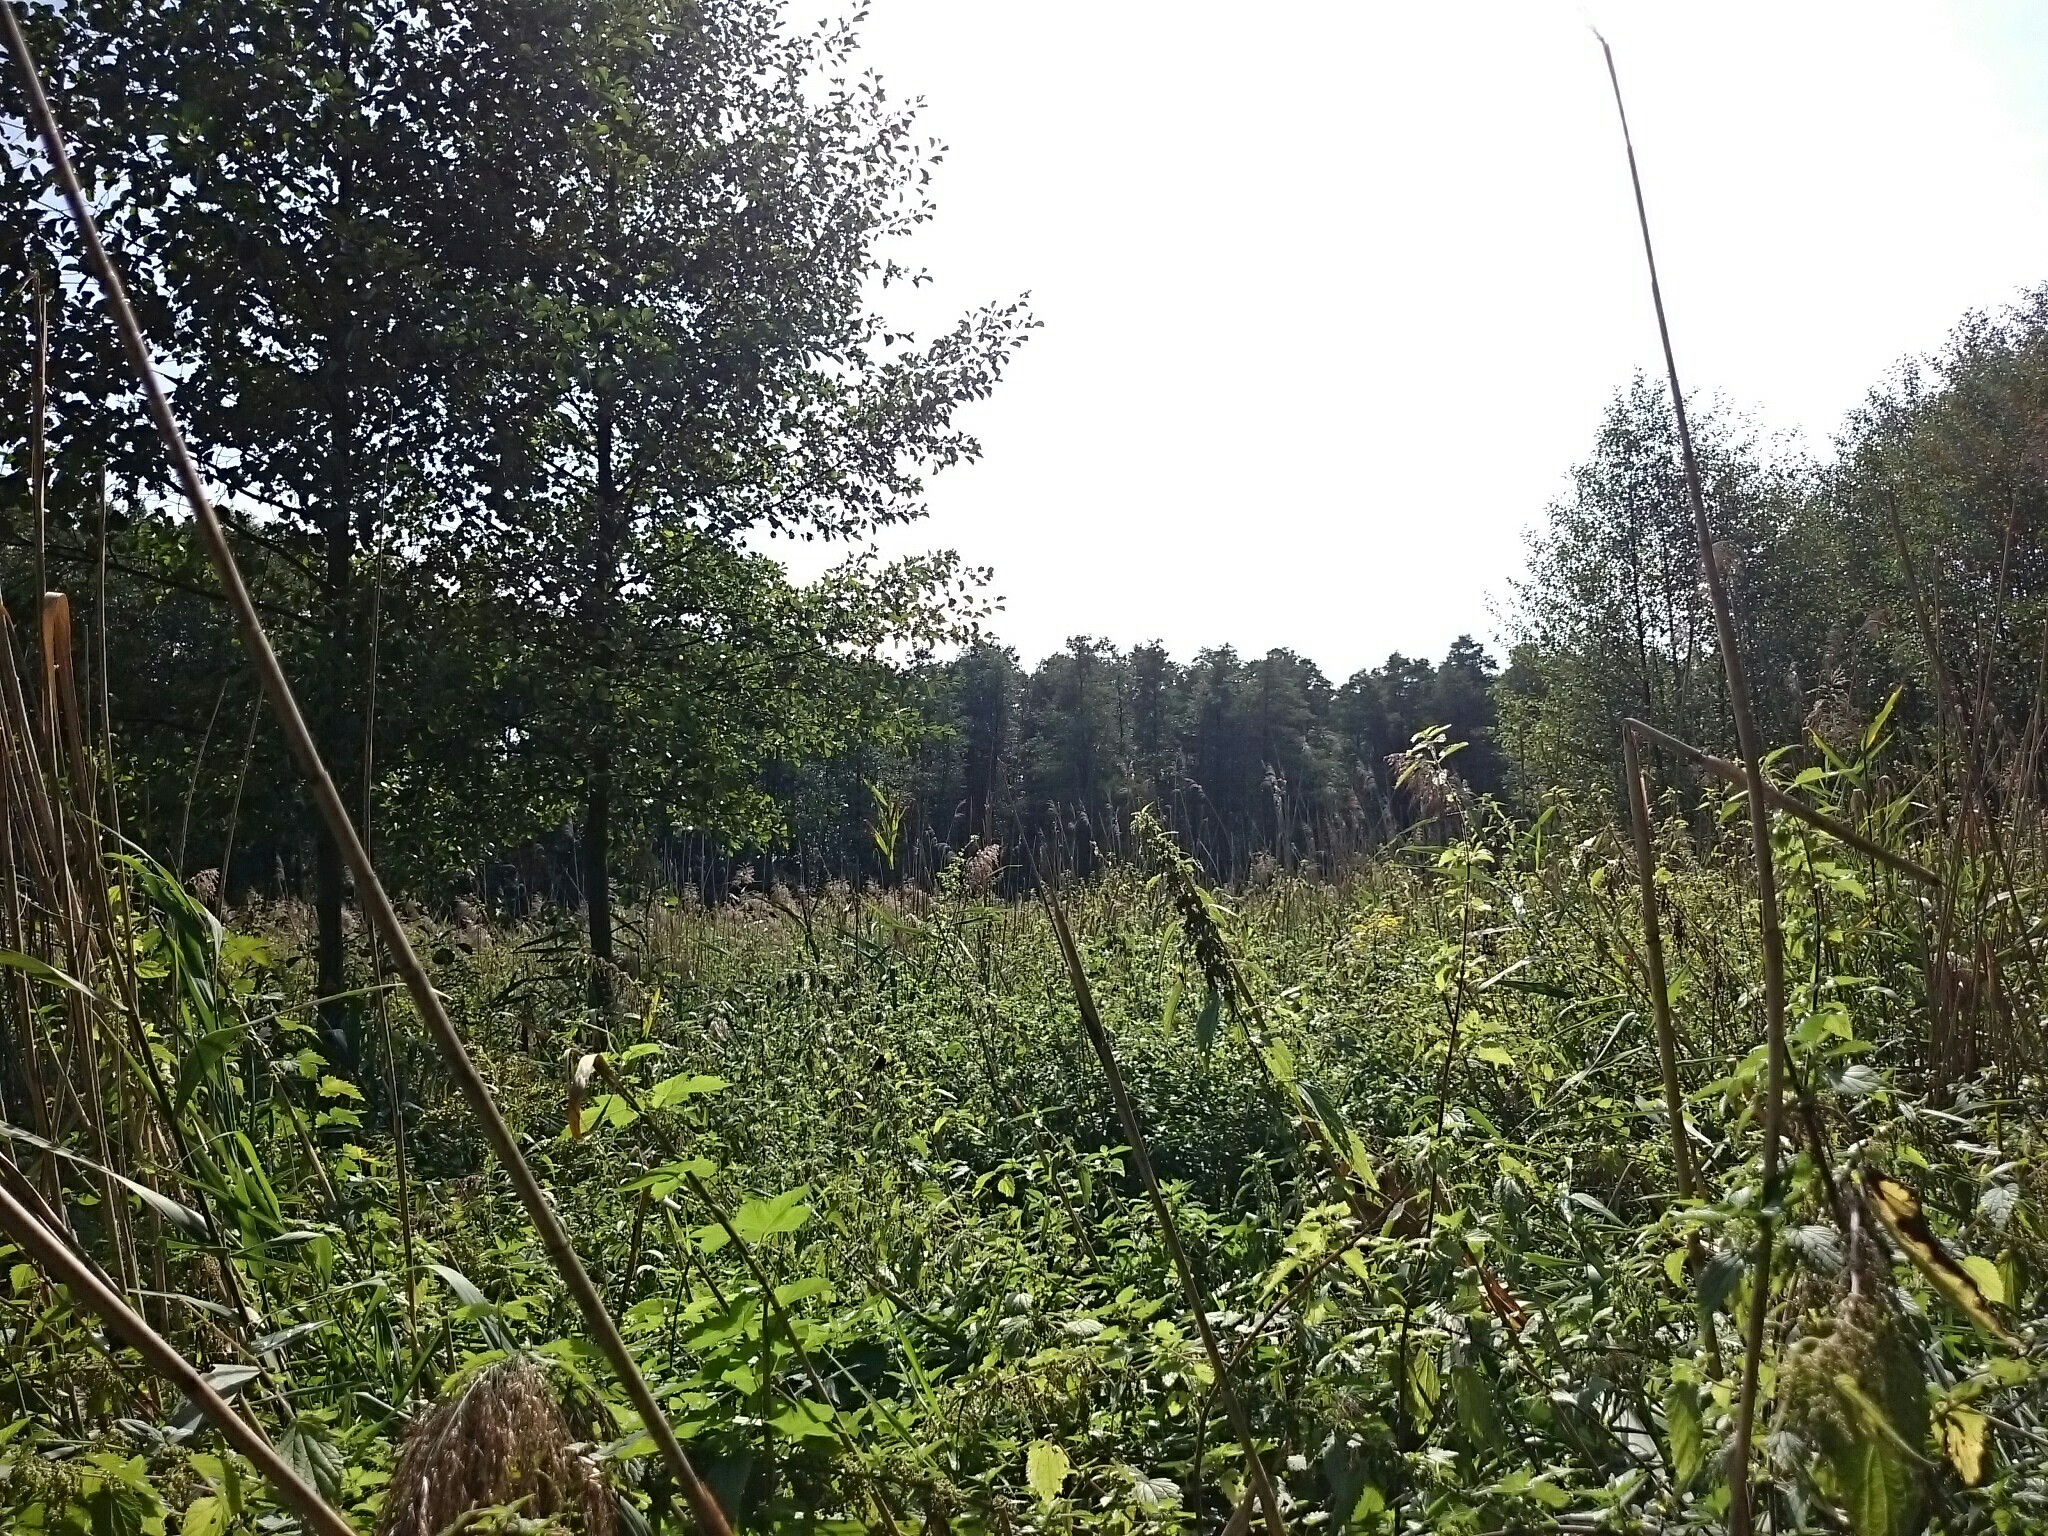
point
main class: Woodland
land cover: Broadleaved woodland
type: mesophytic deciduous forest
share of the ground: > 75 %
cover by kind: broadleaved forest trees 80 %, herbaceous plants 20 %
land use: Forestry
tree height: > 5 m
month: September
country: PL
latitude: 51.1783
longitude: 17.2928
